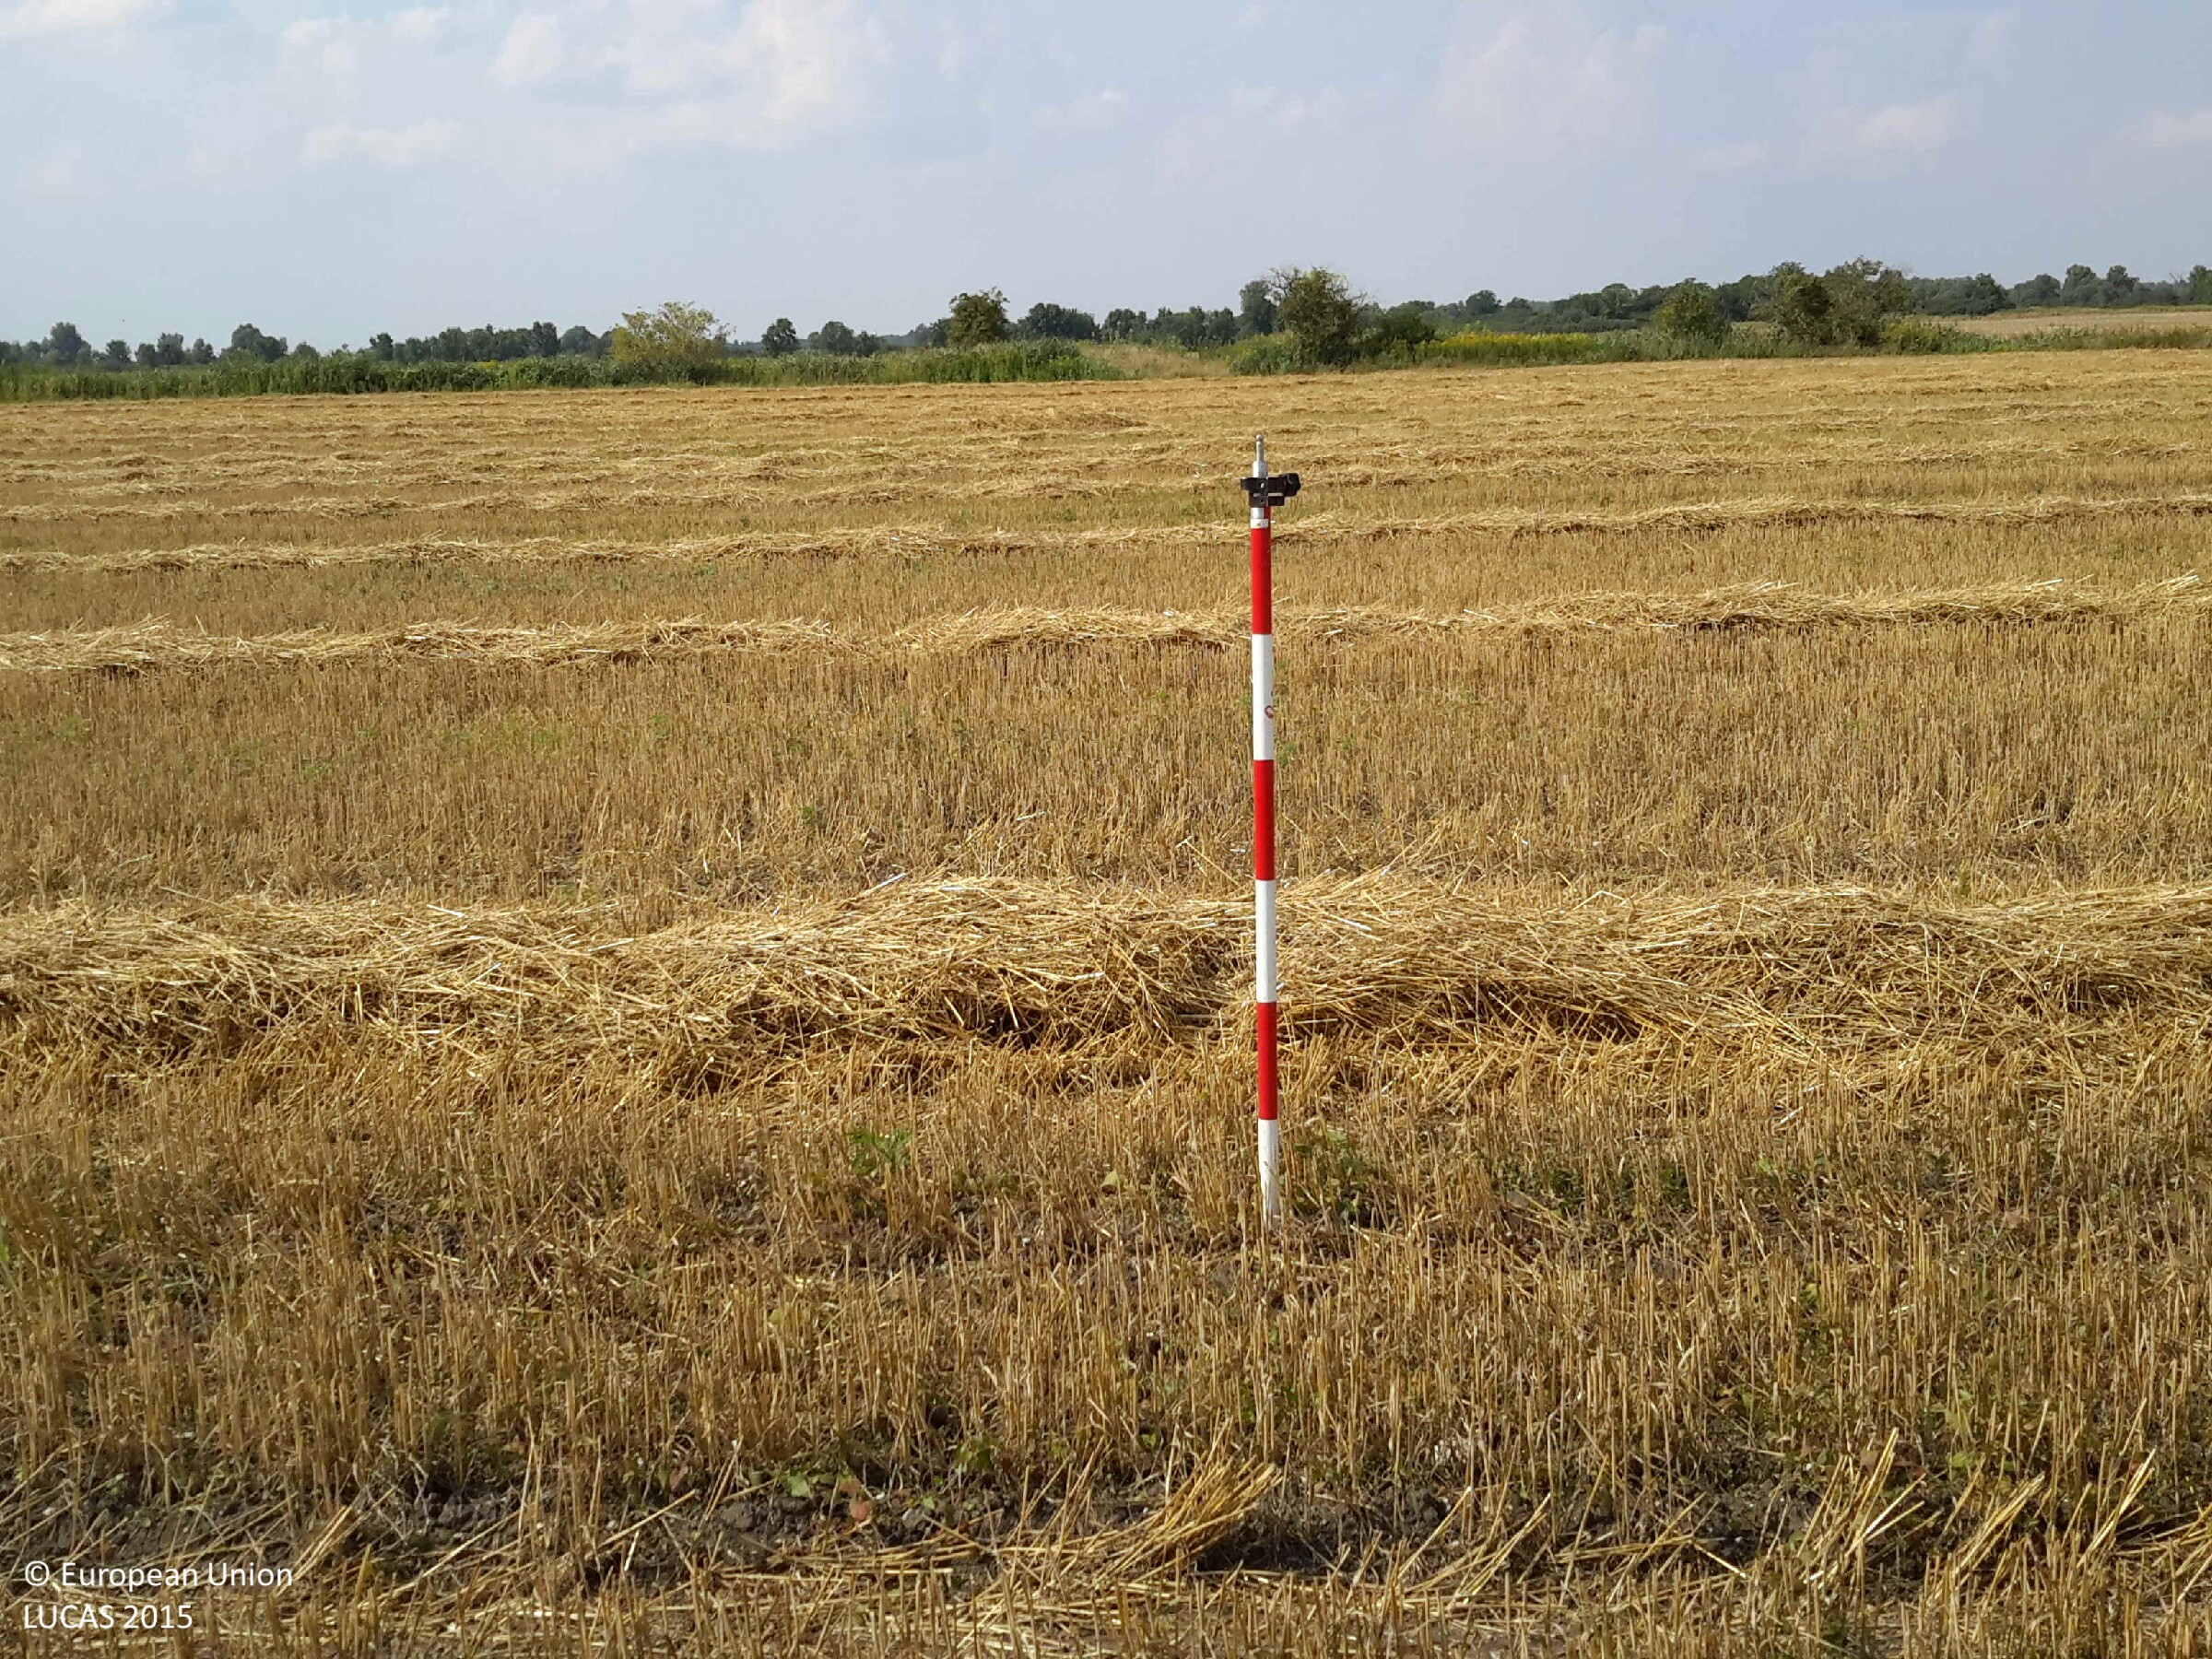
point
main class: Cropland
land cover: Common wheat
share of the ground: 50 - 75 %
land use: Agriculture (excluding fallow land and kitchen gardens)
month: August
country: HU
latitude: 47.3239
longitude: 17.4033
